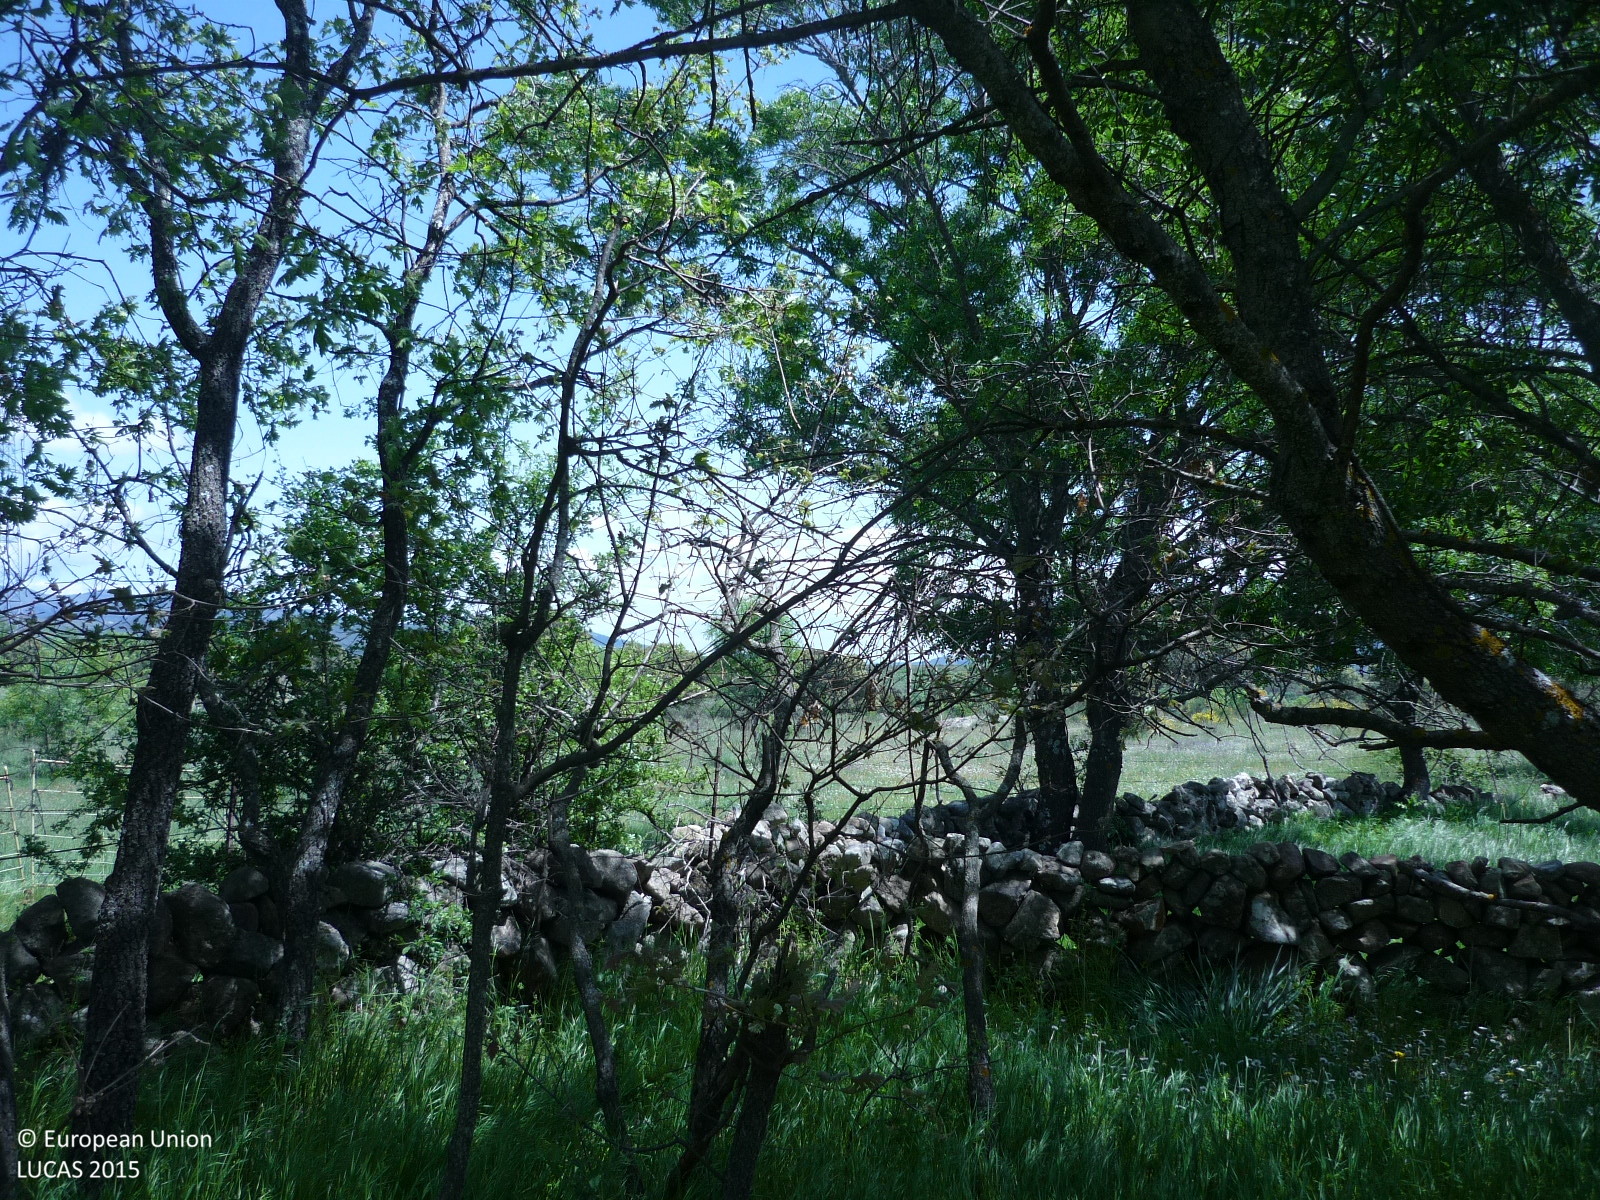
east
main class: Woodland
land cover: Broadleaved woodland
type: thermophilous deciduous forest
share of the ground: 50 - 75 %
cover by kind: broadleaved forest trees 60 %, herbaceous plants 30 %, shrubs 10 %
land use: Semi-natural and natural areas not in use
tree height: < 5 m
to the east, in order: Broadleaved woodland; Dry stone walls; Grassland with sparse tree/shrub cover; Fences; Grassland with sparse tree/shrub cover; Fences; Grassland with sparse tree/shrub cover; Dry stone walls; Grassland with sparse tree/shrub cover; Electric lines; Grassland with sparse tree/shrub cover
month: May
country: ES
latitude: 40.9280
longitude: -3.5925
